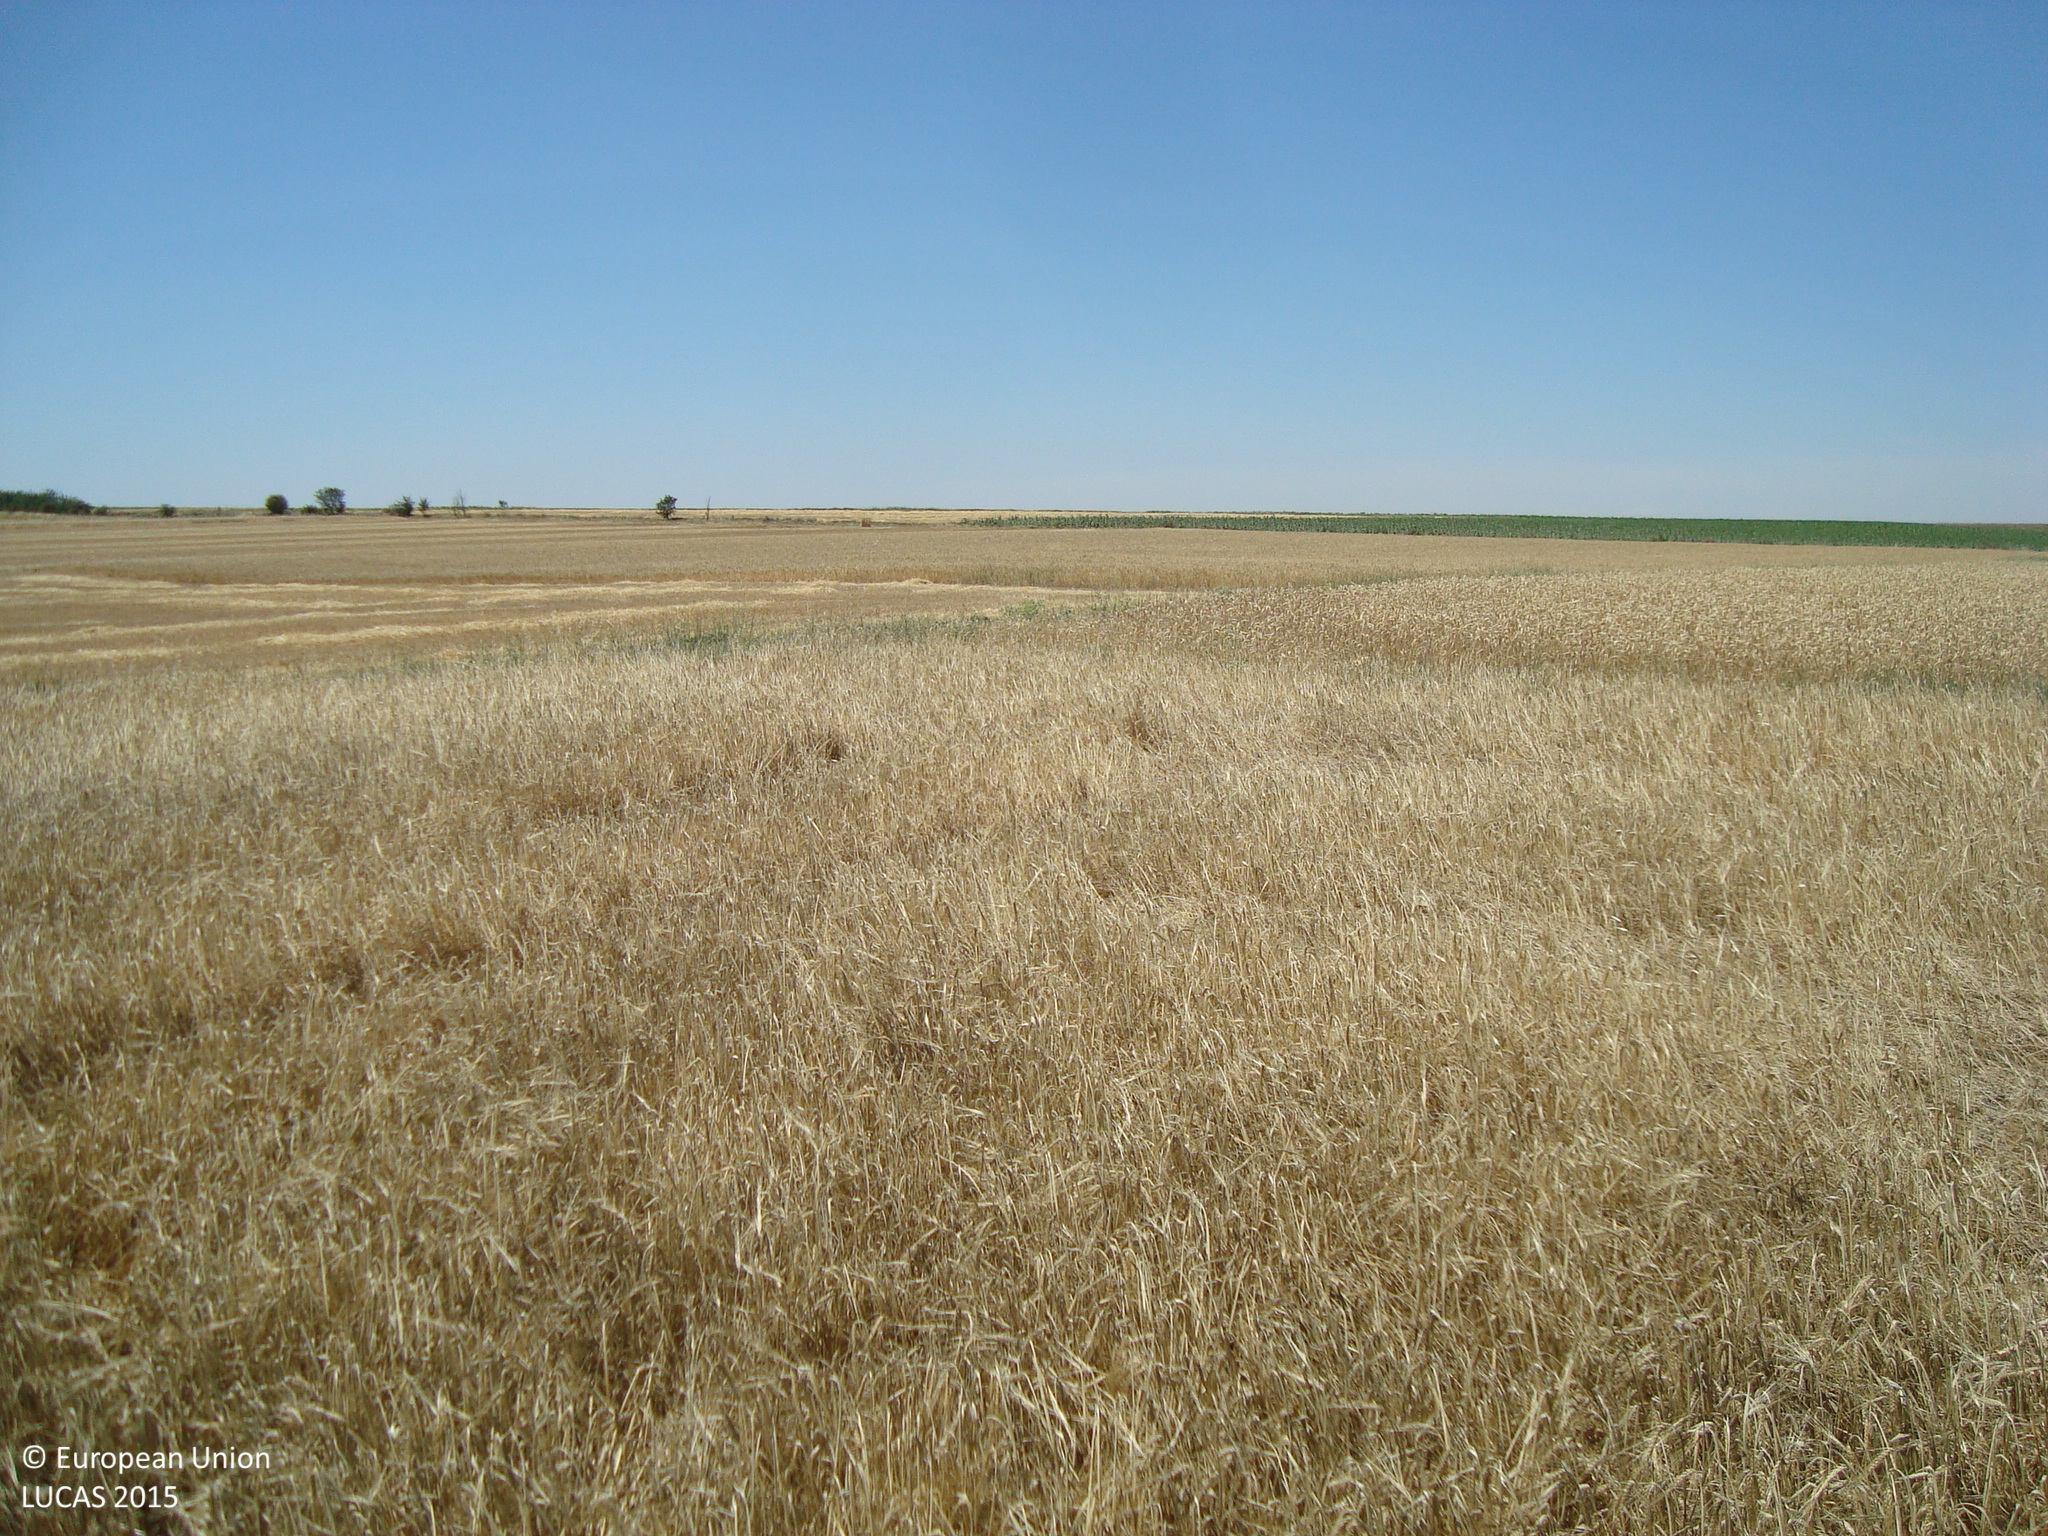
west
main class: Cropland
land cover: Barley
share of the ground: > 75 %
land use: Agriculture (excluding fallow land and kitchen gardens)
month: July
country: ES
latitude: 42.1283
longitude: -4.7985
